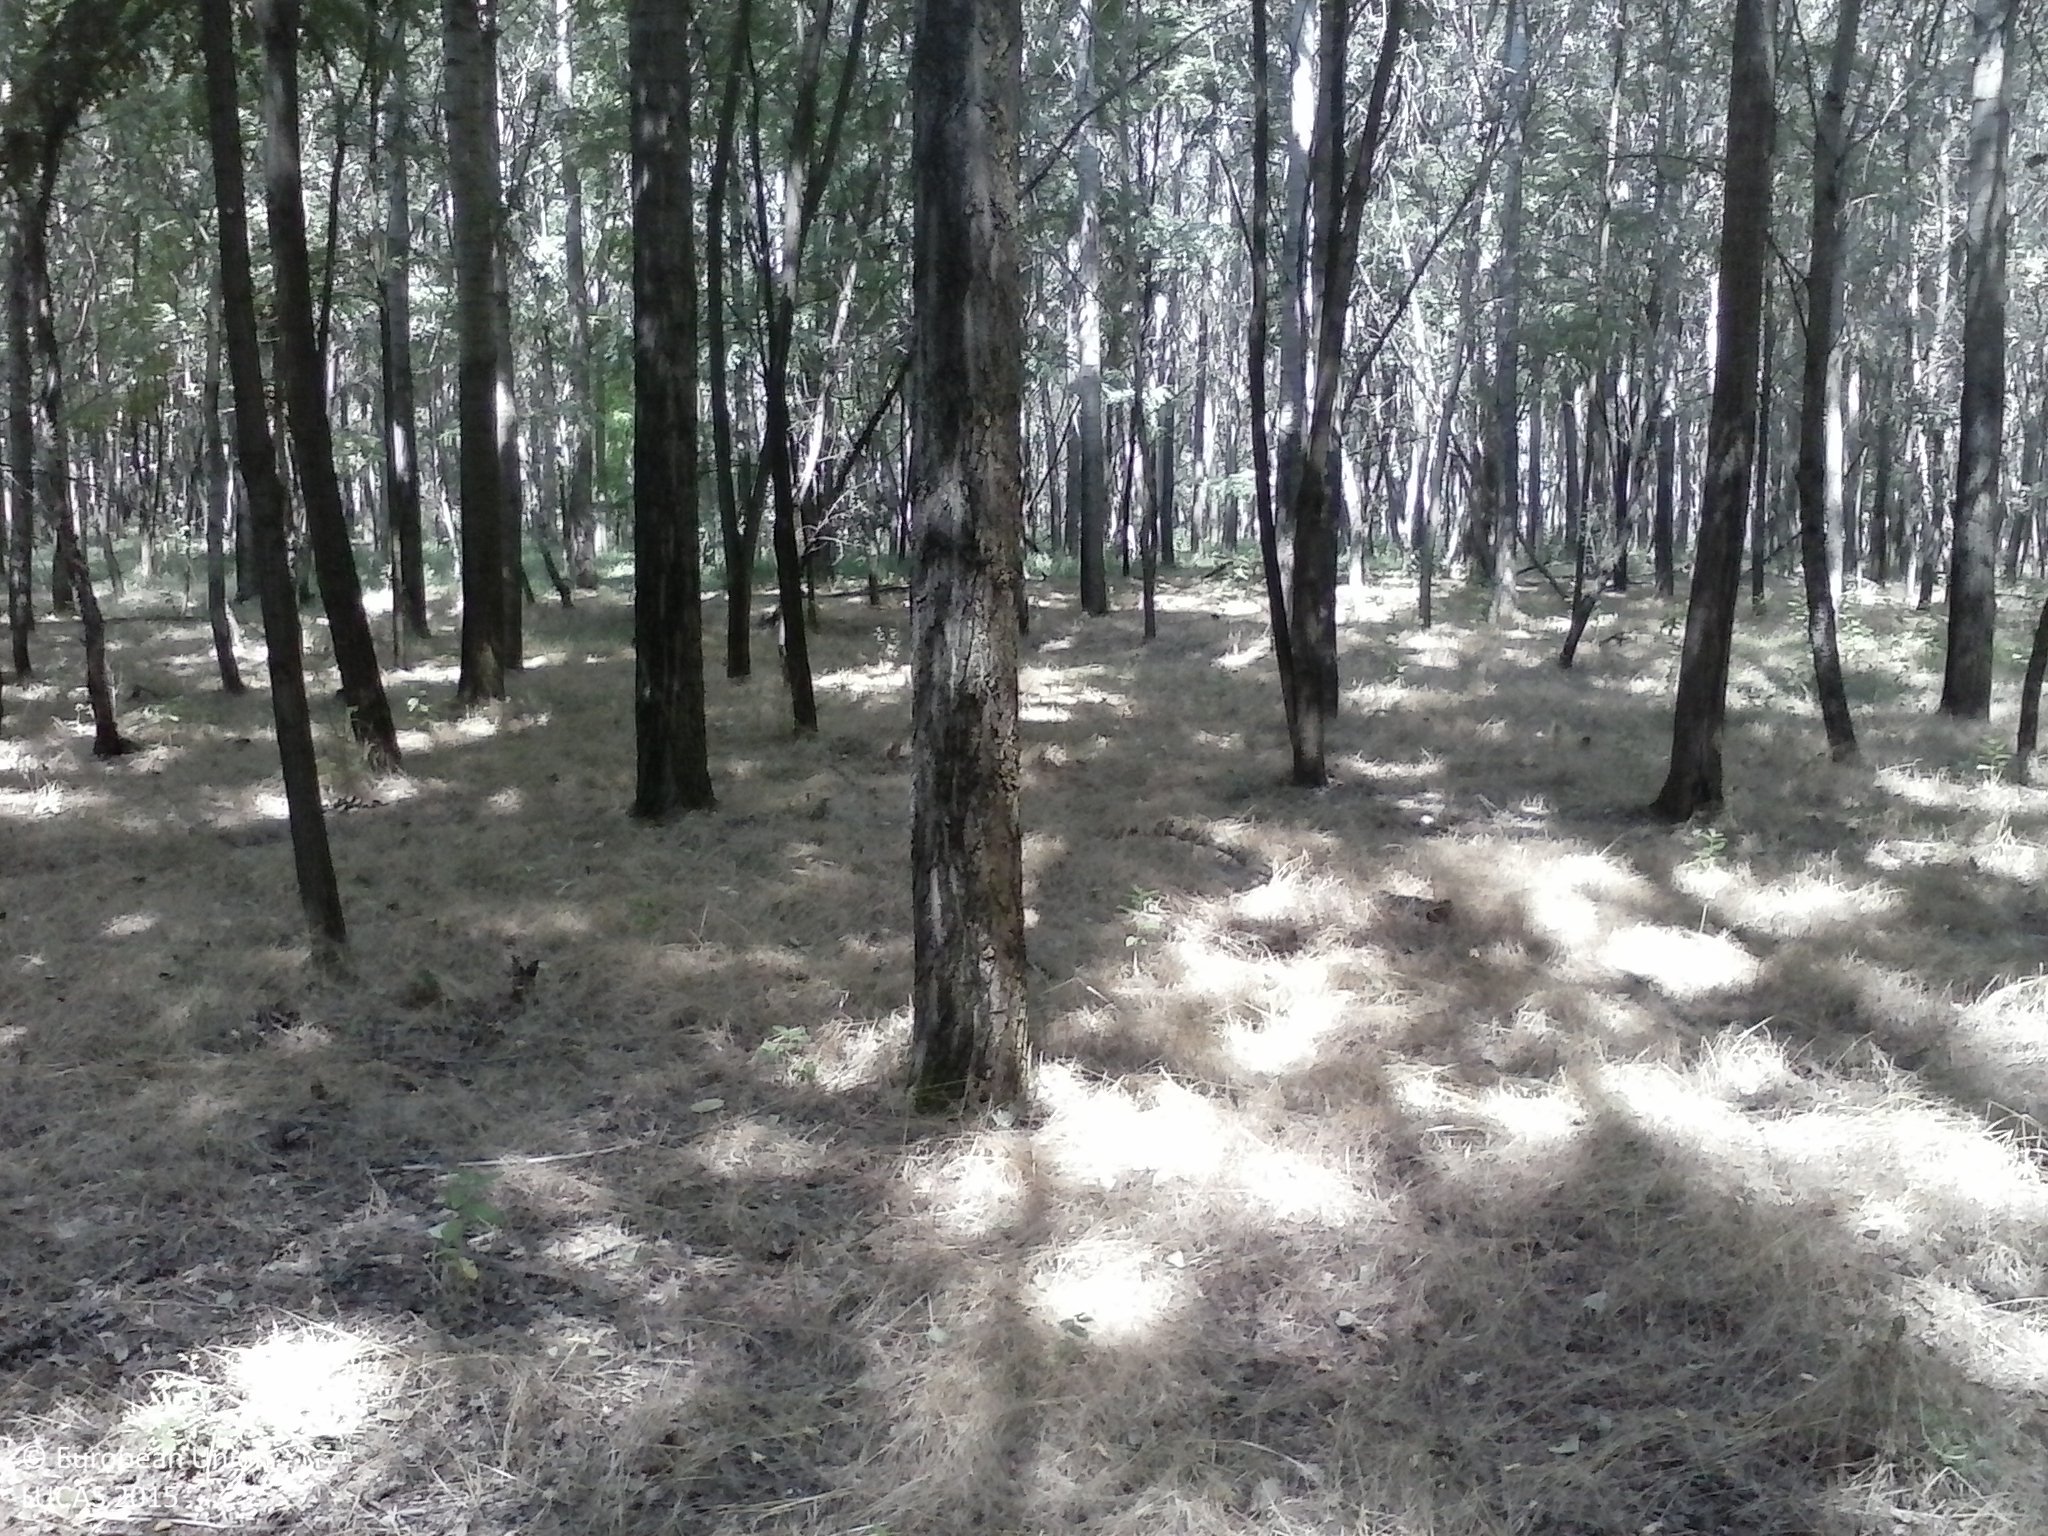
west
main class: Woodland
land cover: Broadleaved woodland
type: mesophytic deciduous forest
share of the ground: > 75 %
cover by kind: broadleaved forest trees 90 %, herbaceous plants 10 %
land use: Forestry
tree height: > 5 m
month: July
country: HU
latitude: 46.4945
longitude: 19.6470
